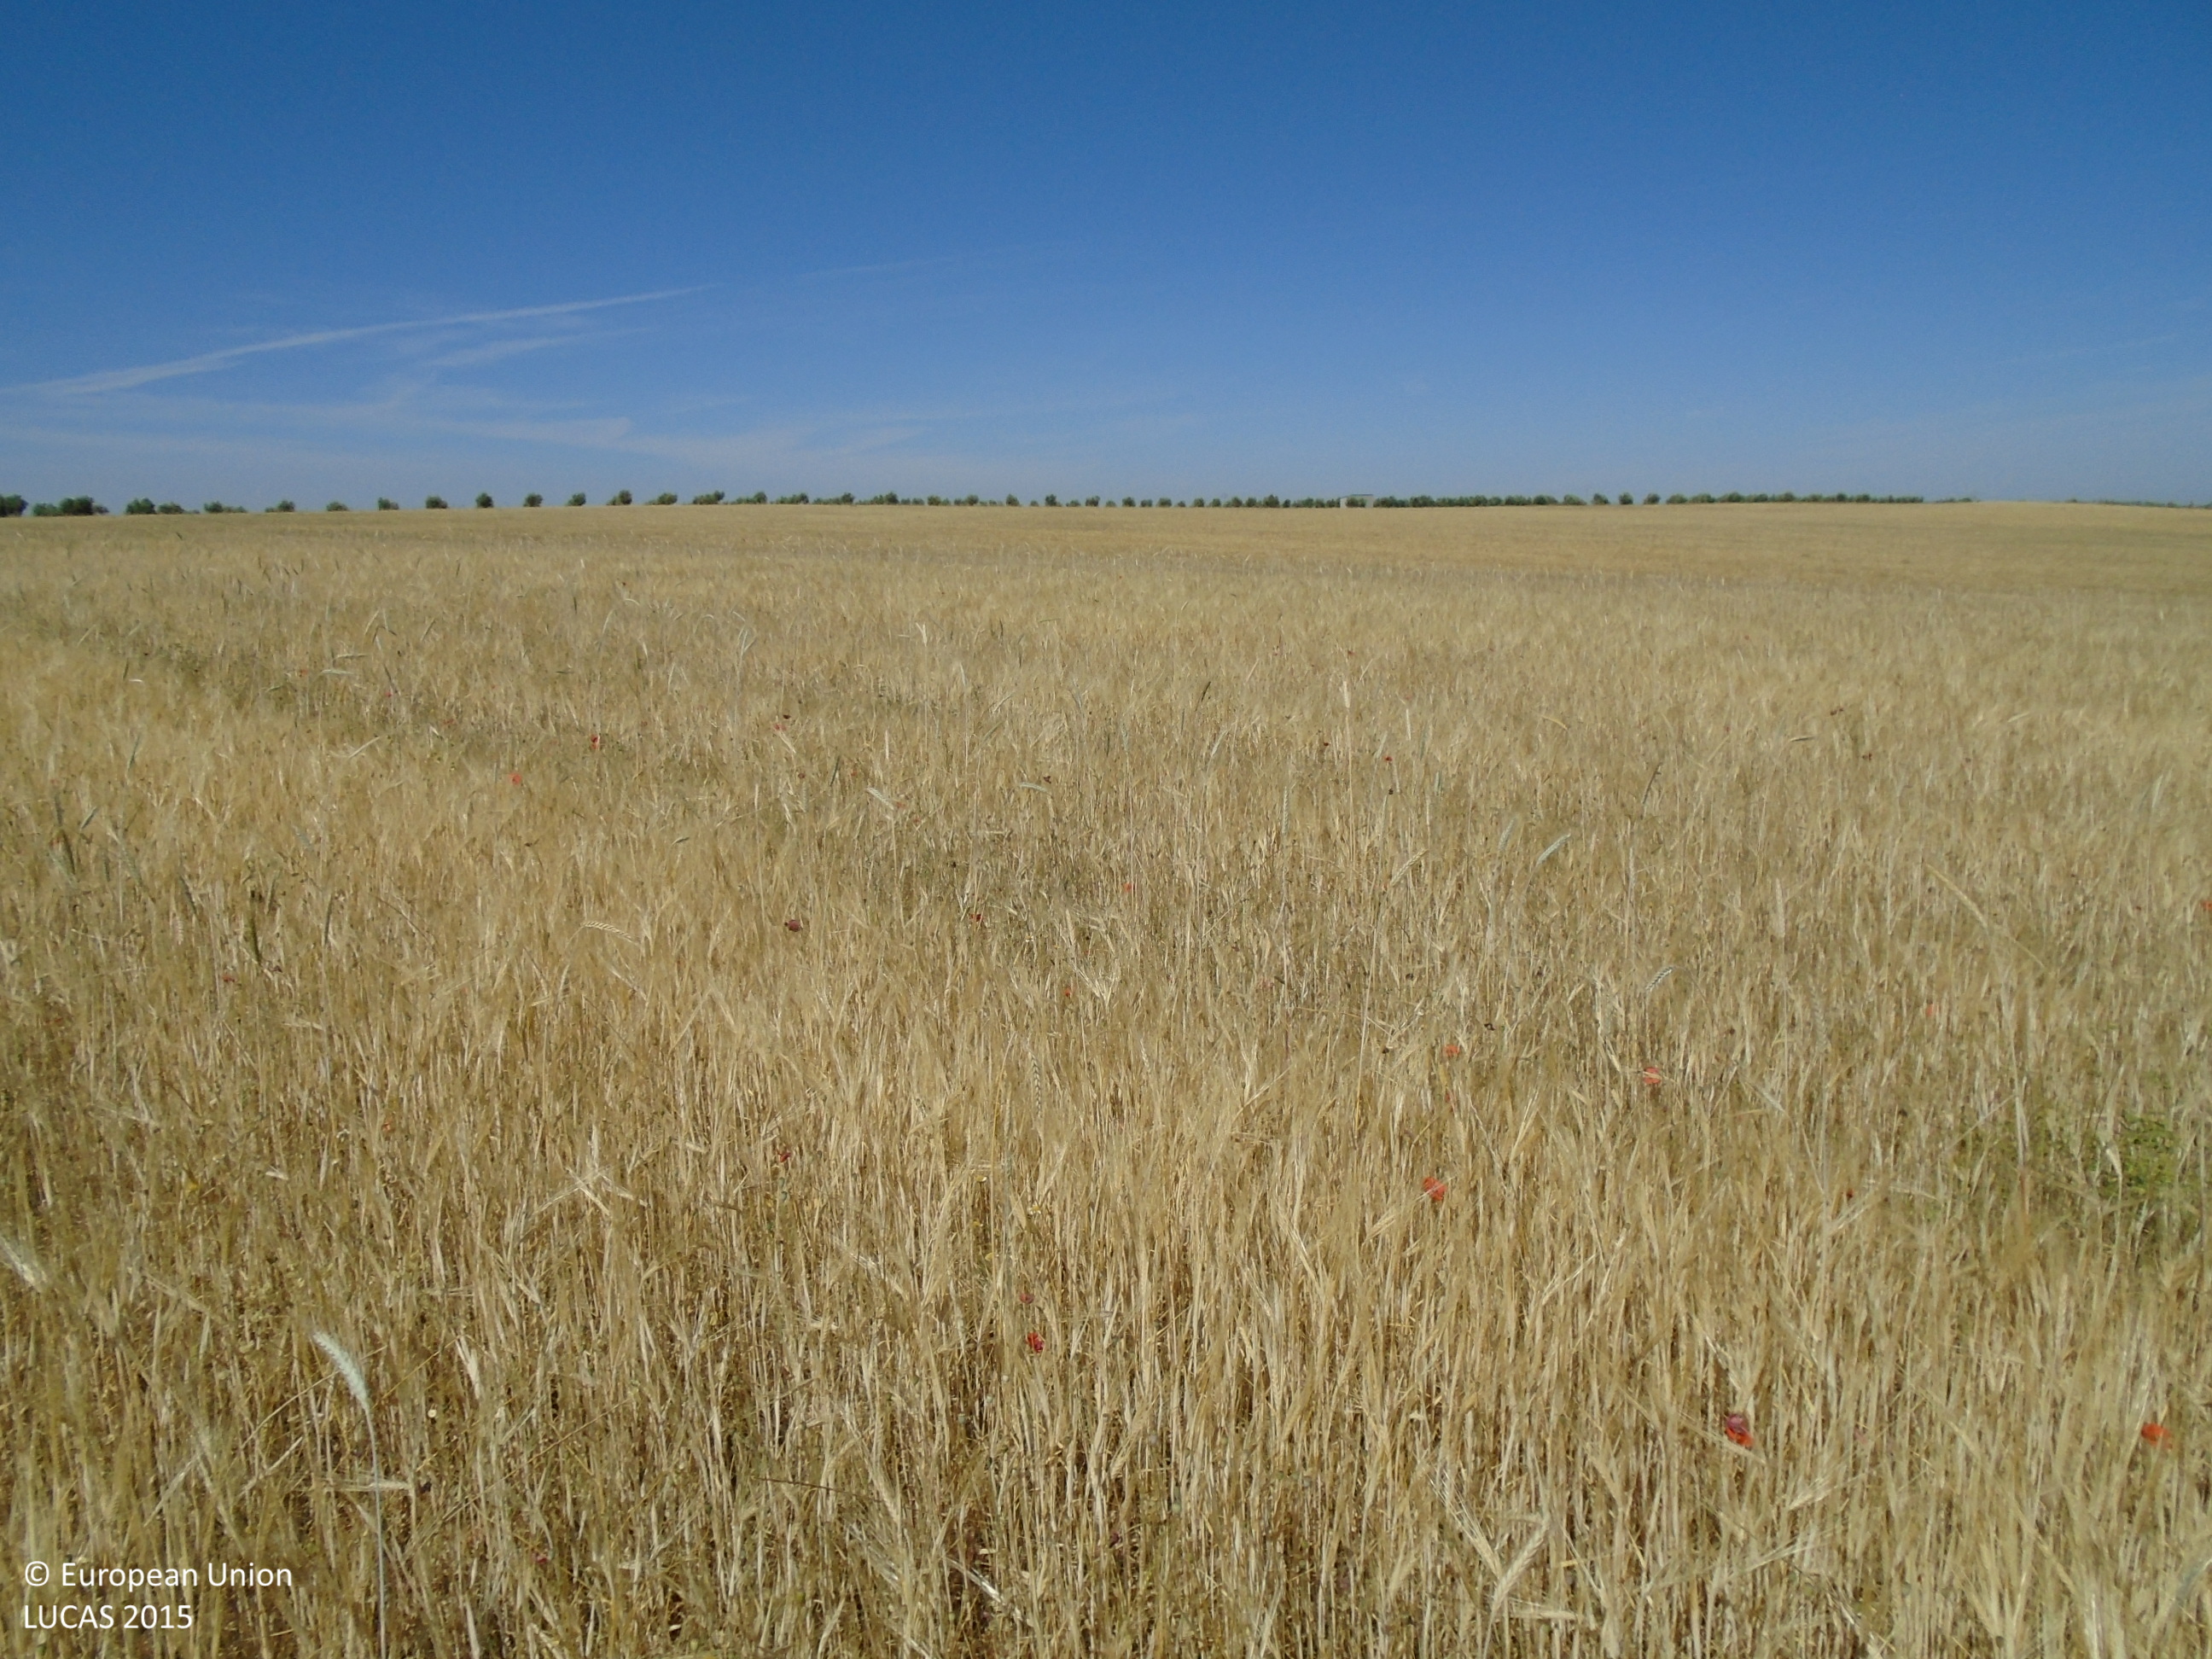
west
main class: Cropland
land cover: Barley
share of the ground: > 75 %
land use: Agriculture (excluding fallow land and kitchen gardens)
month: May
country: ES
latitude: 39.7953
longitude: -3.7048
